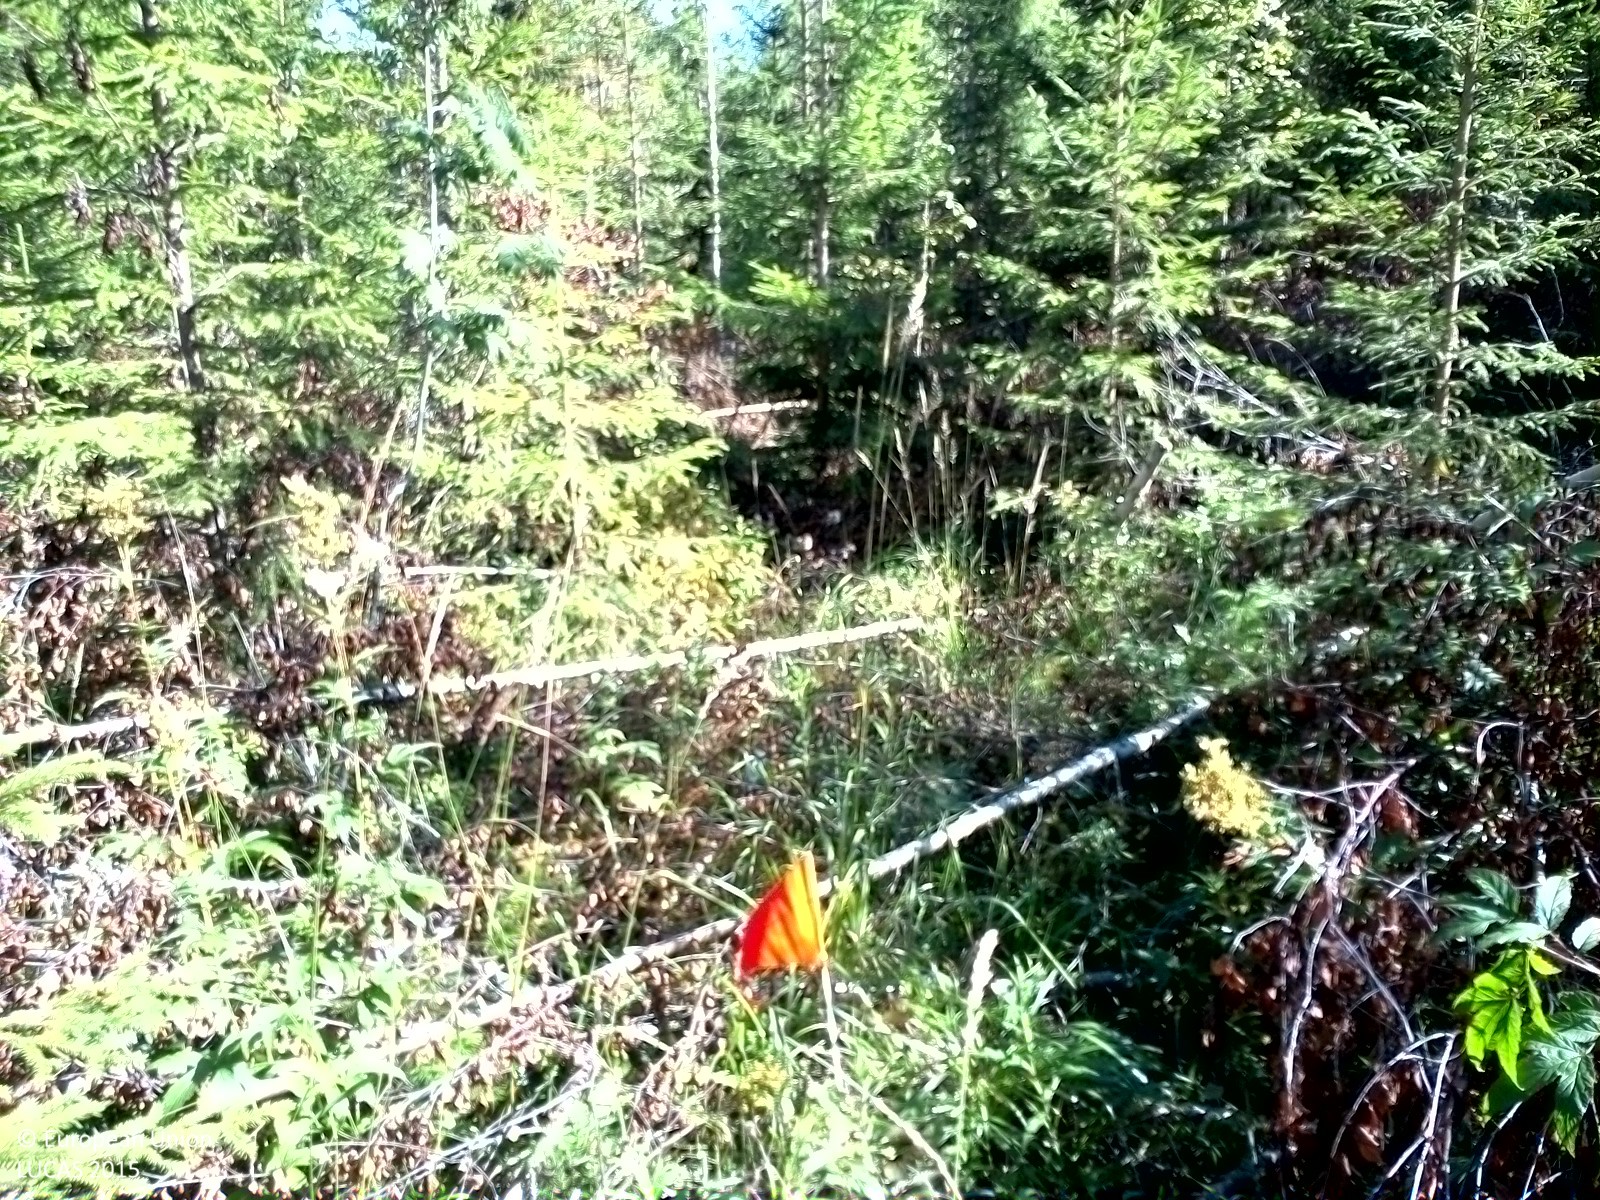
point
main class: Woodland
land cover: Spruce dominated mixed woodland
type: boreal forest
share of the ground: 50 - 75 %
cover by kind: coniferous forest trees 40 %, herbaceous plants 25 %, broadleaved forest trees 20 %, shrubs 15 %
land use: Forestry
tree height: < 5 m
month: August
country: SE
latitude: 62.4192
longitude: 16.4653
